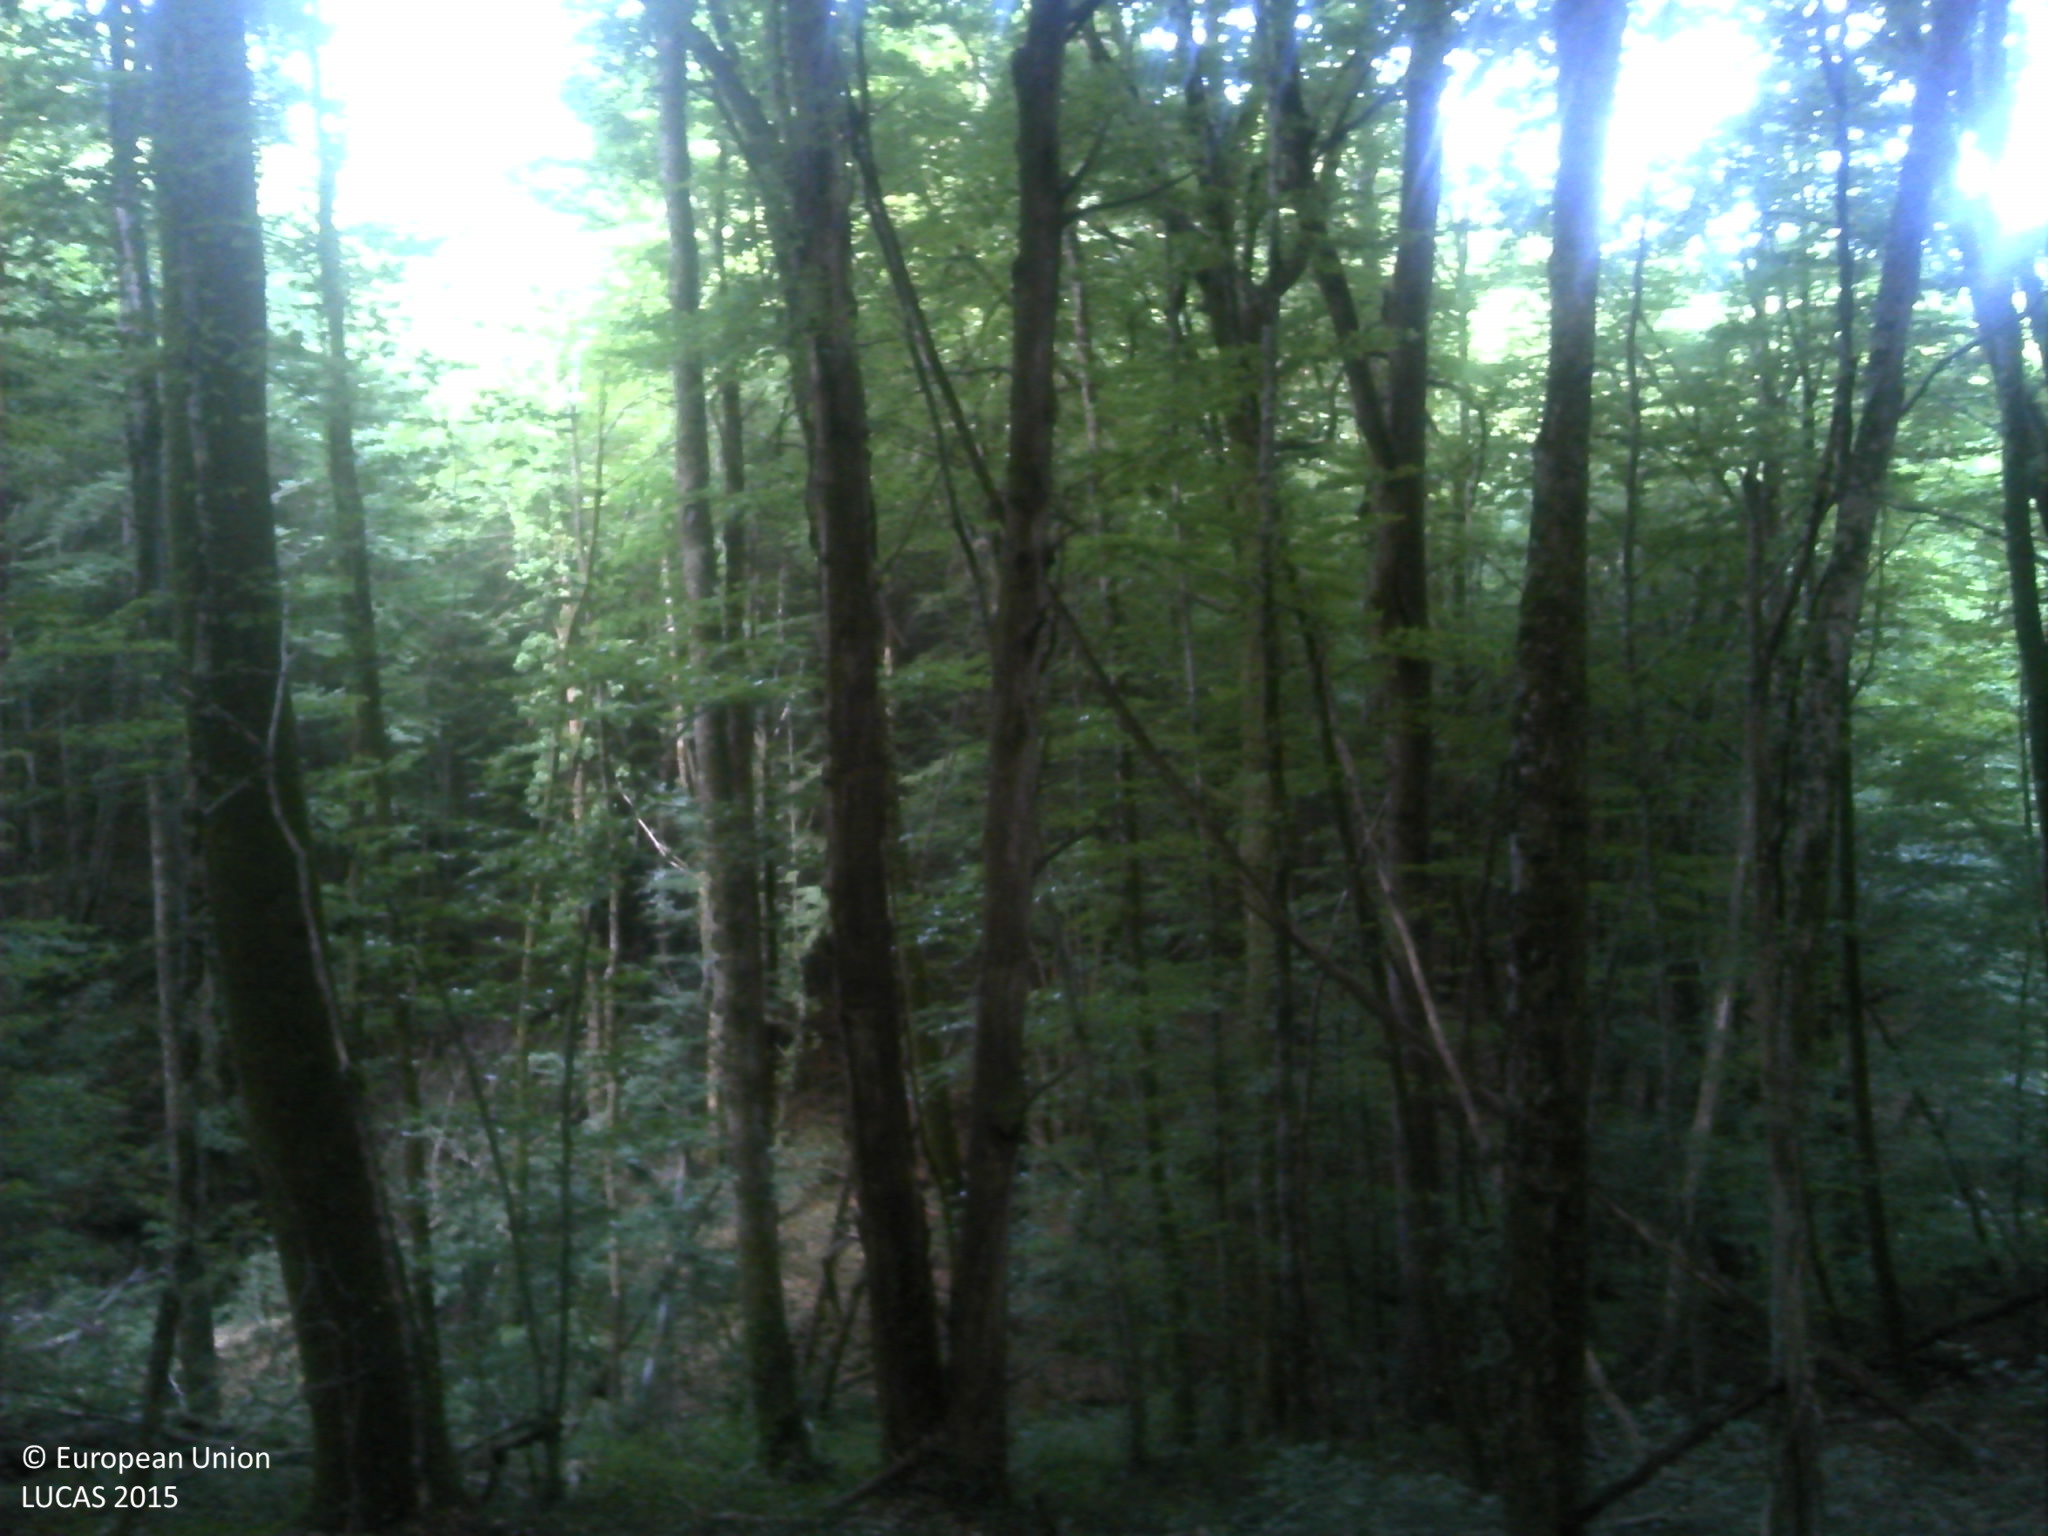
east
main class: Woodland
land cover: Broadleaved woodland
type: acidophilous oak and oak-birch forest
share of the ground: > 75 %
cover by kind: broadleaved forest trees 55 %, unconsolidated bare surface 30 %, lichens and mosses 10 %, herbaceous plants 5 %
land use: Forestry
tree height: > 5 m
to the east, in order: Broadleaved woodland; Tracks; Broadleaved woodland; Tracks; Broadleaved woodland; Dry stone walls; Grassland without tree/shrub cover; Electric lines; Grassland without tree/shrub cover
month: July
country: FR
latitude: 45.2139
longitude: 1.7066
